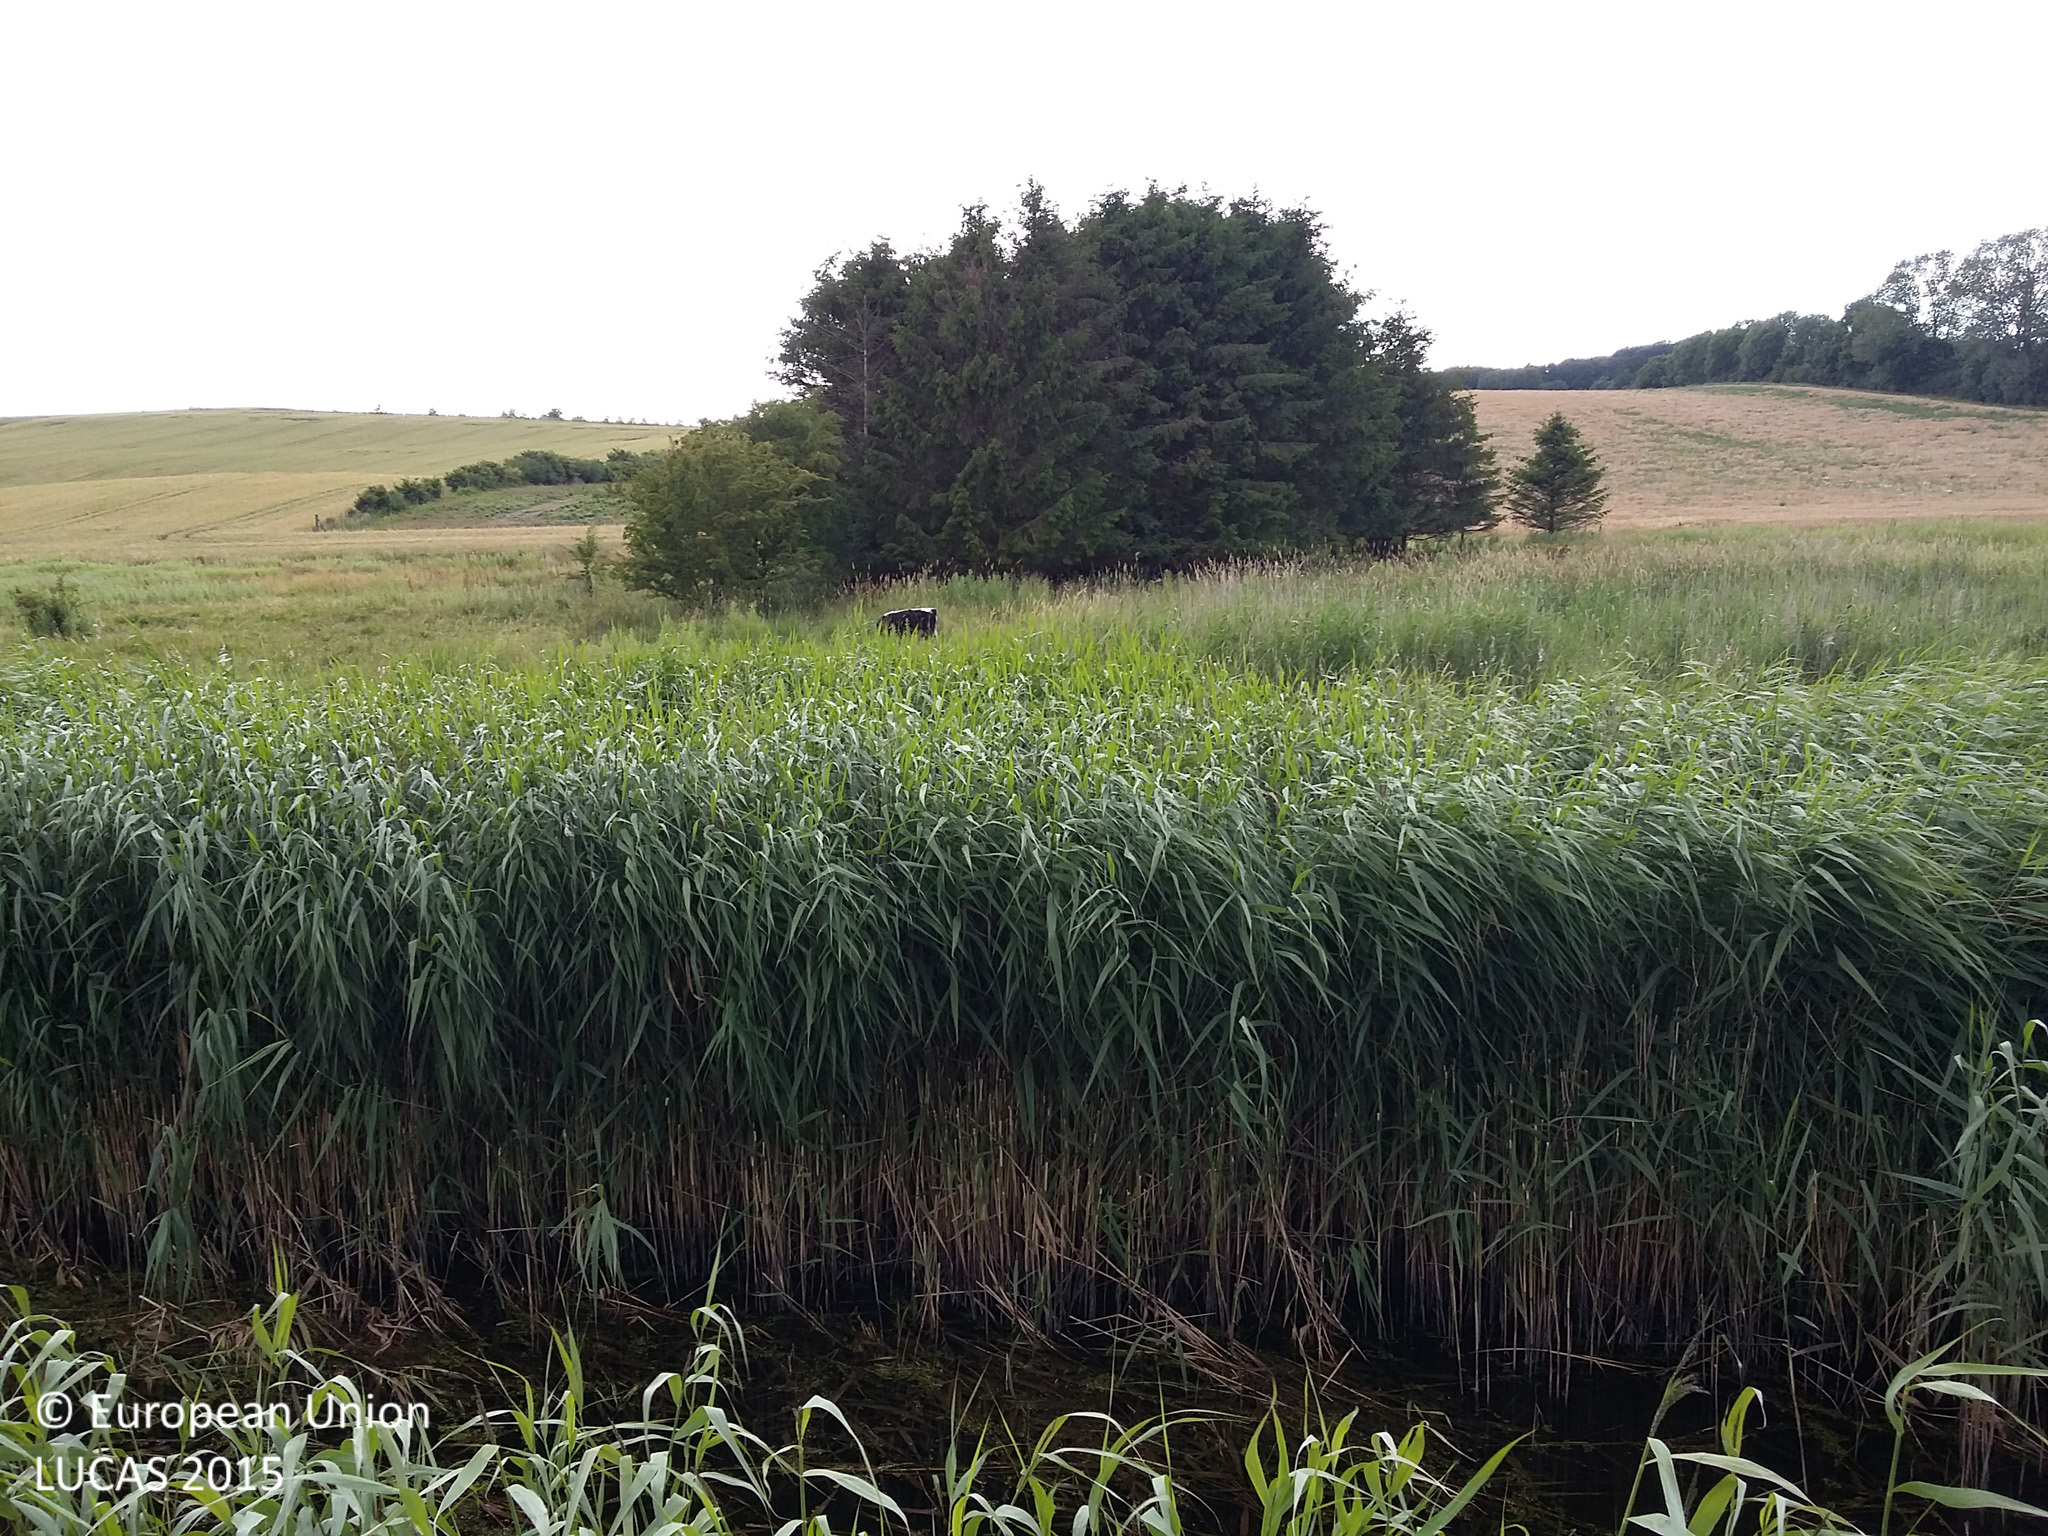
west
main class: Cropland
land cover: Barley
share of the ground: > 75 %
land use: Agriculture (excluding fallow land and kitchen gardens)
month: July
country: DK
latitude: 55.7844
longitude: 11.4178
